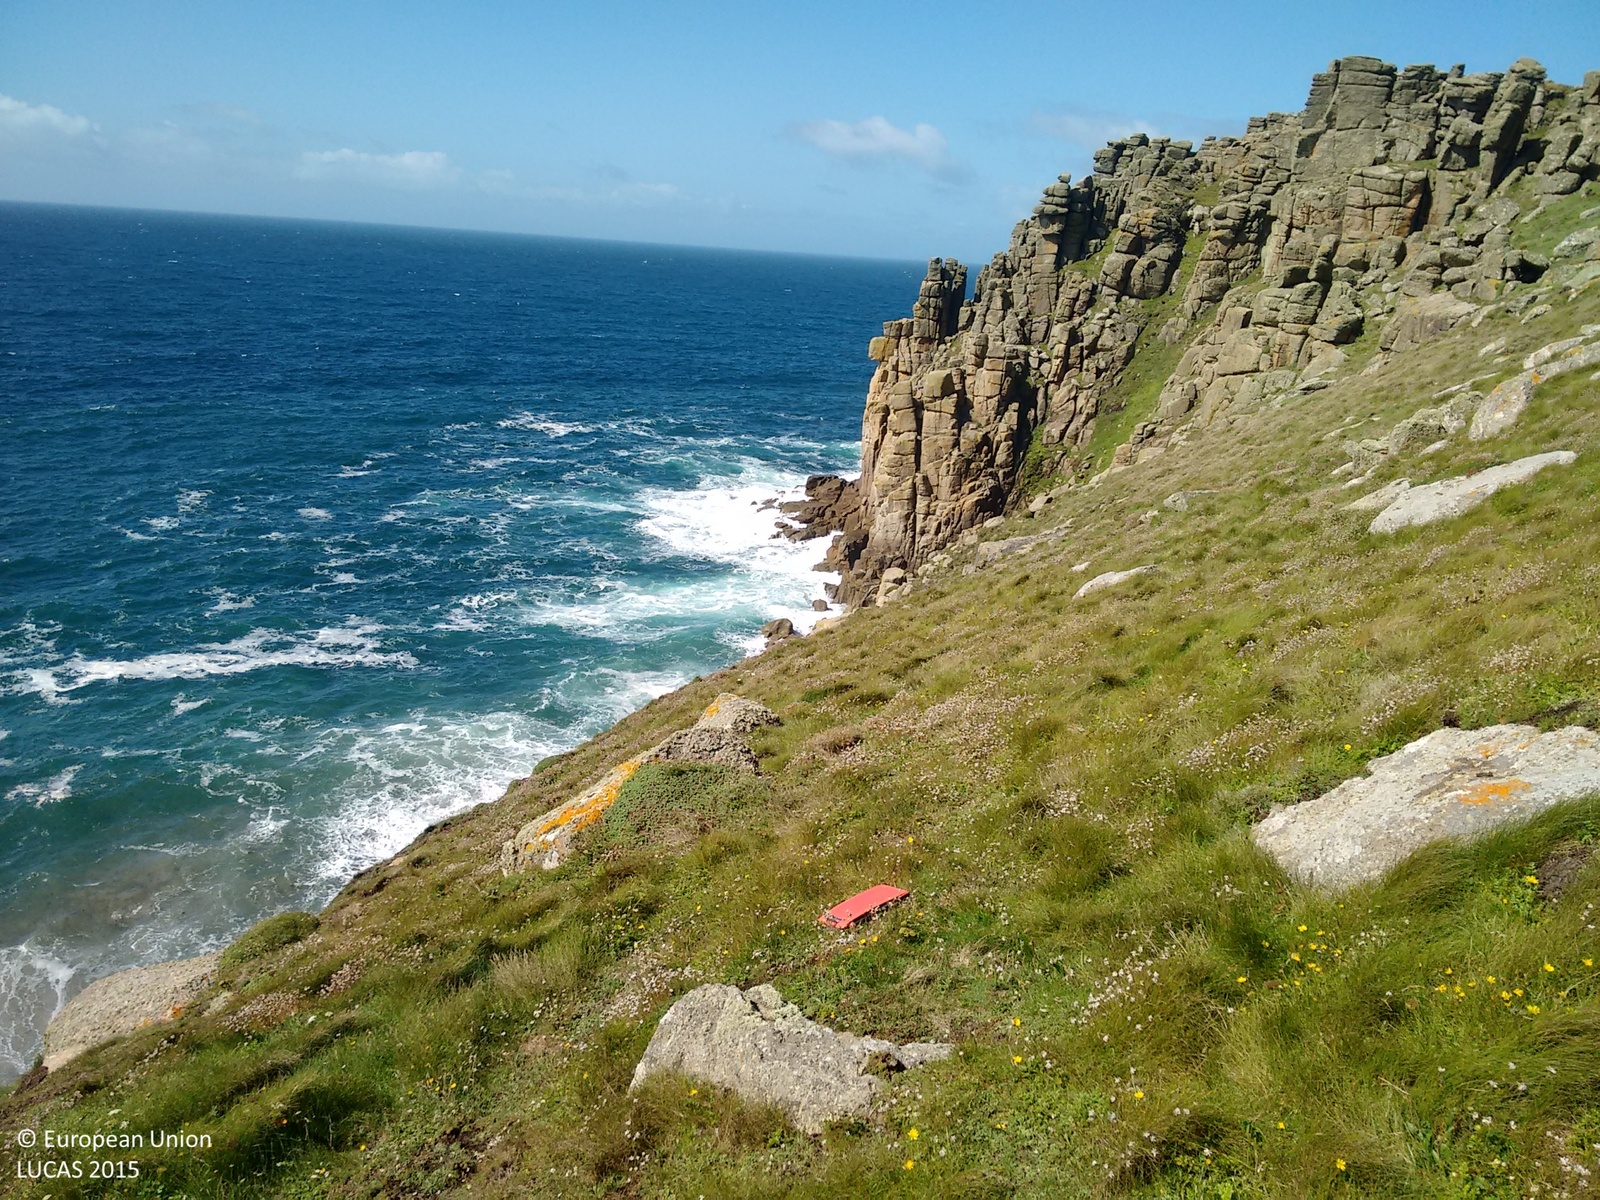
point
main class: Grassland
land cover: Grassland without tree/shrub cover
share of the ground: > 75 %
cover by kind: herbaceous plants 90 %, unconsolidated bare surface 10 %
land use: Agriculture (excluding fallow land and kitchen gardens)
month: August
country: GB
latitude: 50.0577
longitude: -5.7069
